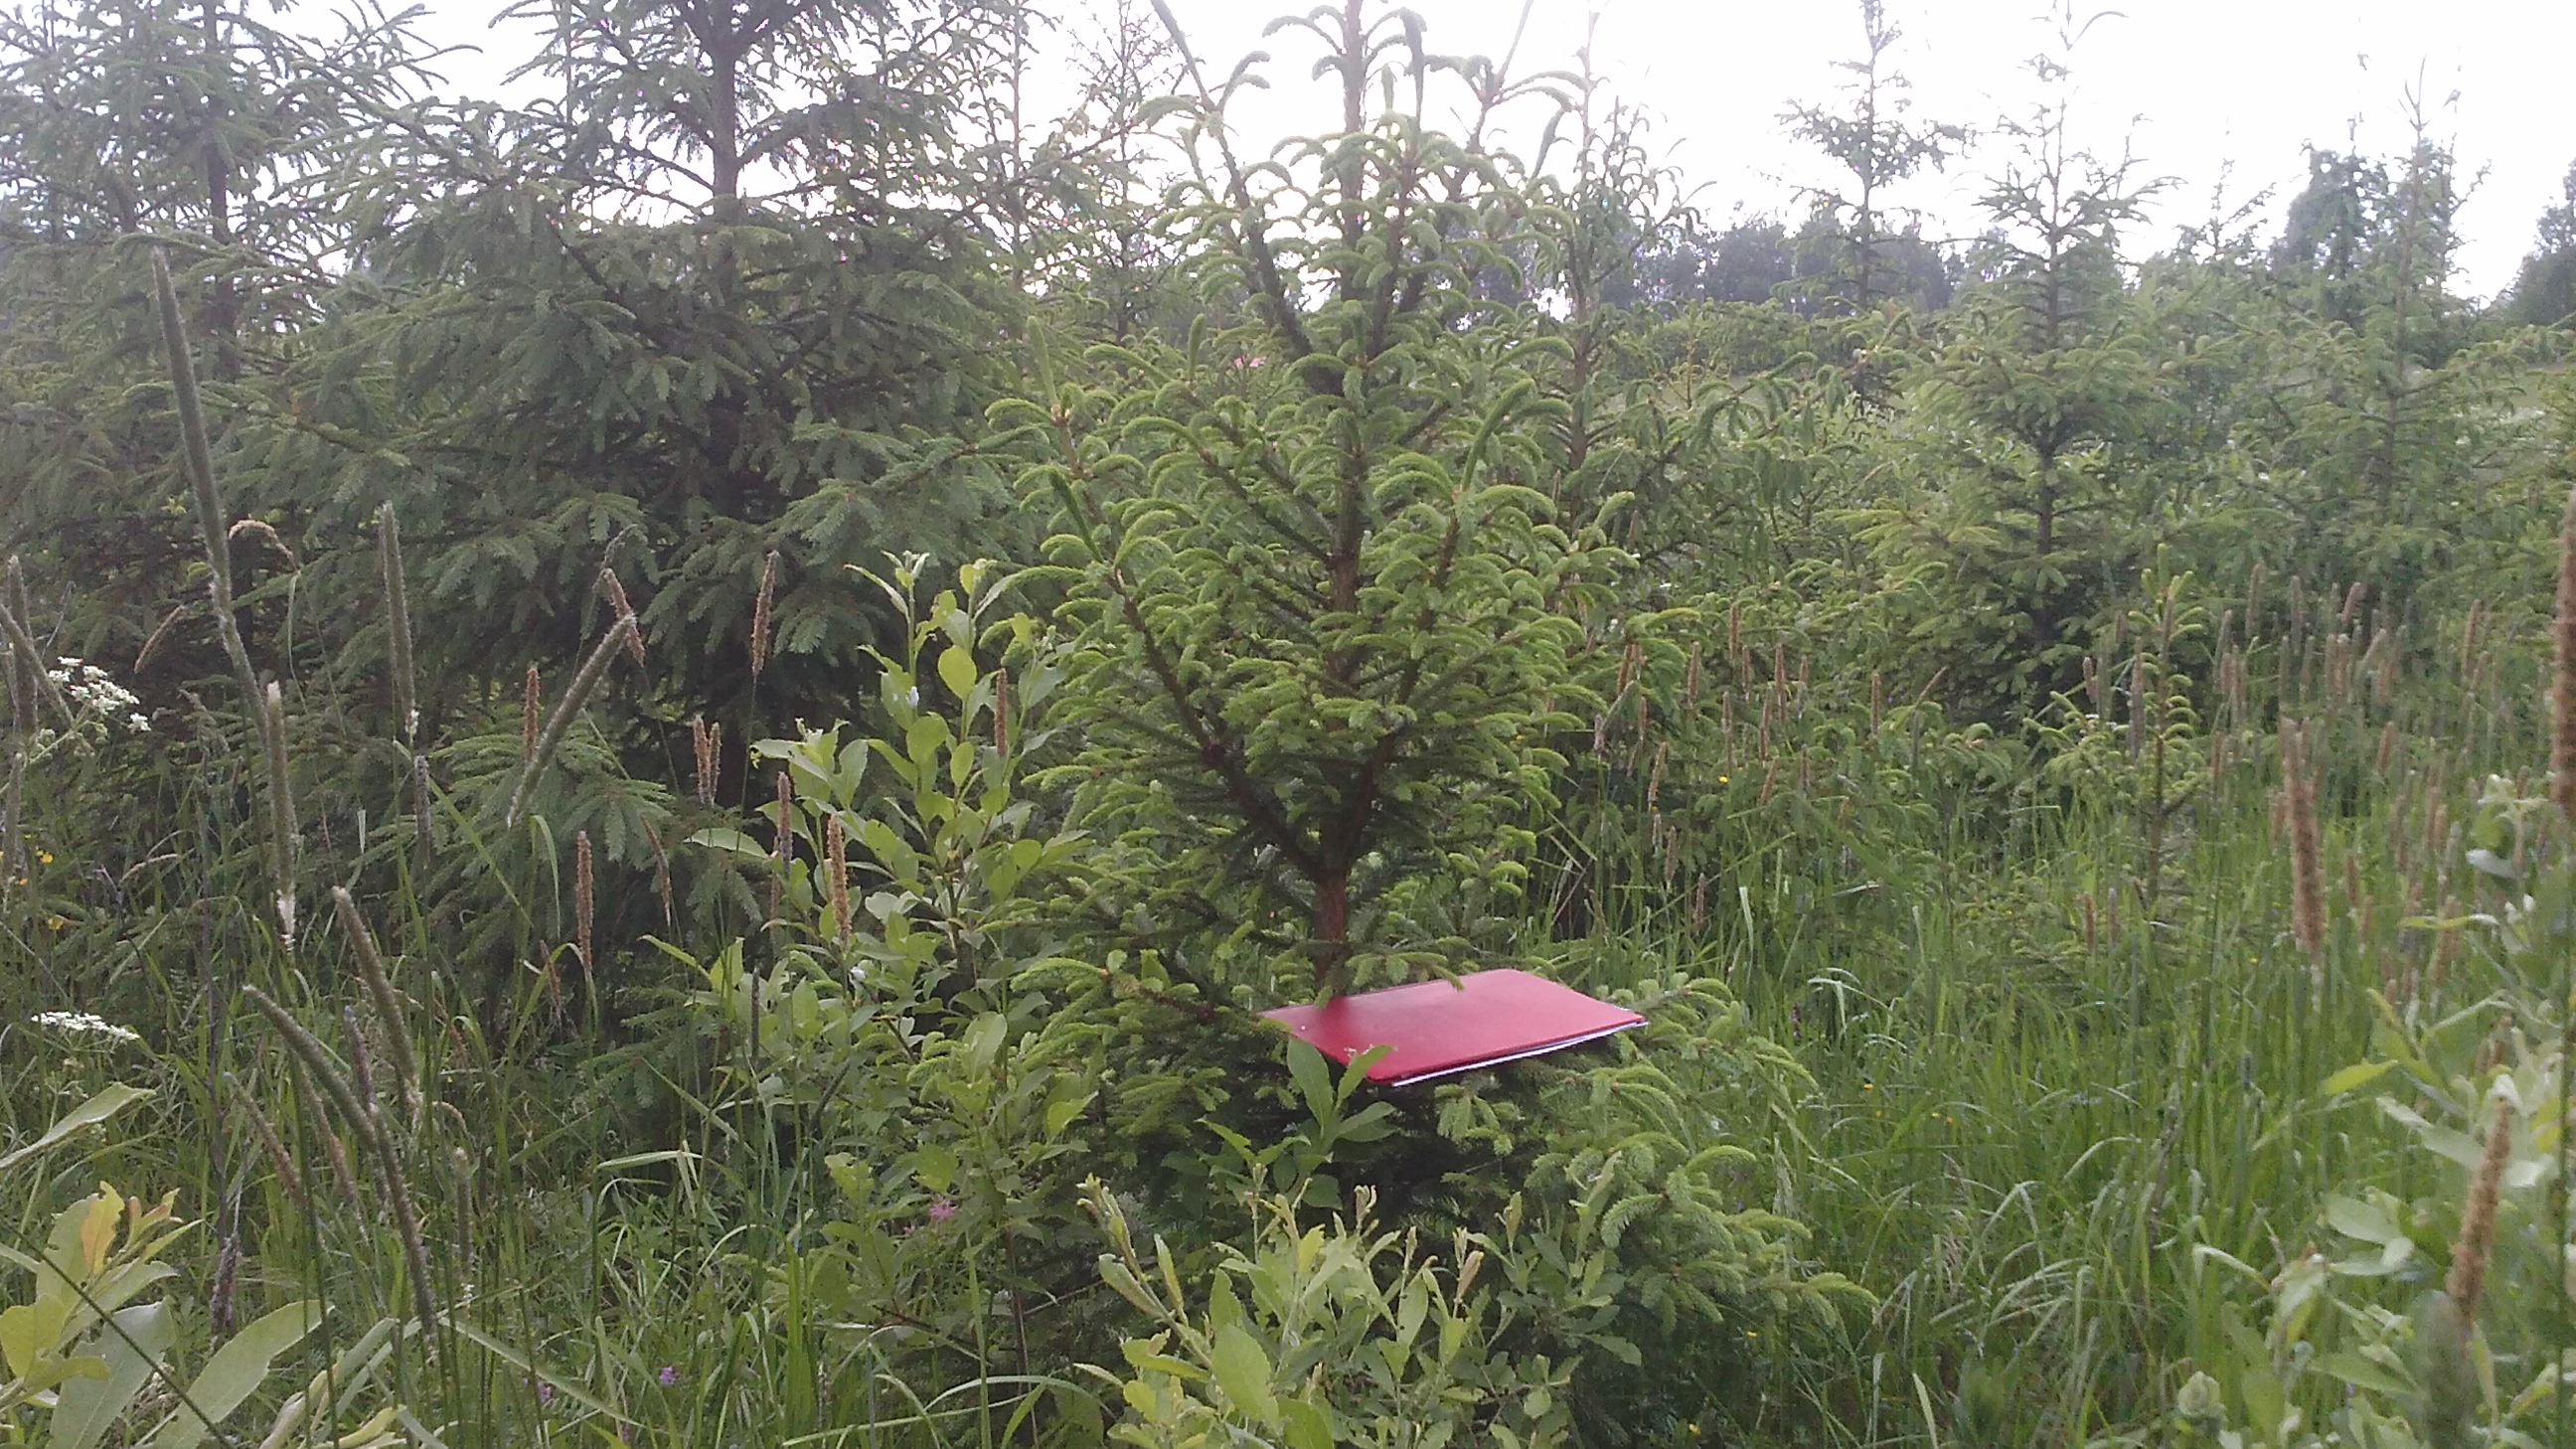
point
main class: Woodland
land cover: Spruce dominated coniferous woodland
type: hemiboreal forest and nemoral coniferous forest and mixed broadleaved-coniferous forest
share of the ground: > 75 %
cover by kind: coniferous forest trees 80 %, herbaceous plants 20 %
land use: Forestry
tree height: < 5 m
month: June
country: LV
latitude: 56.4356
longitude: 27.4499
